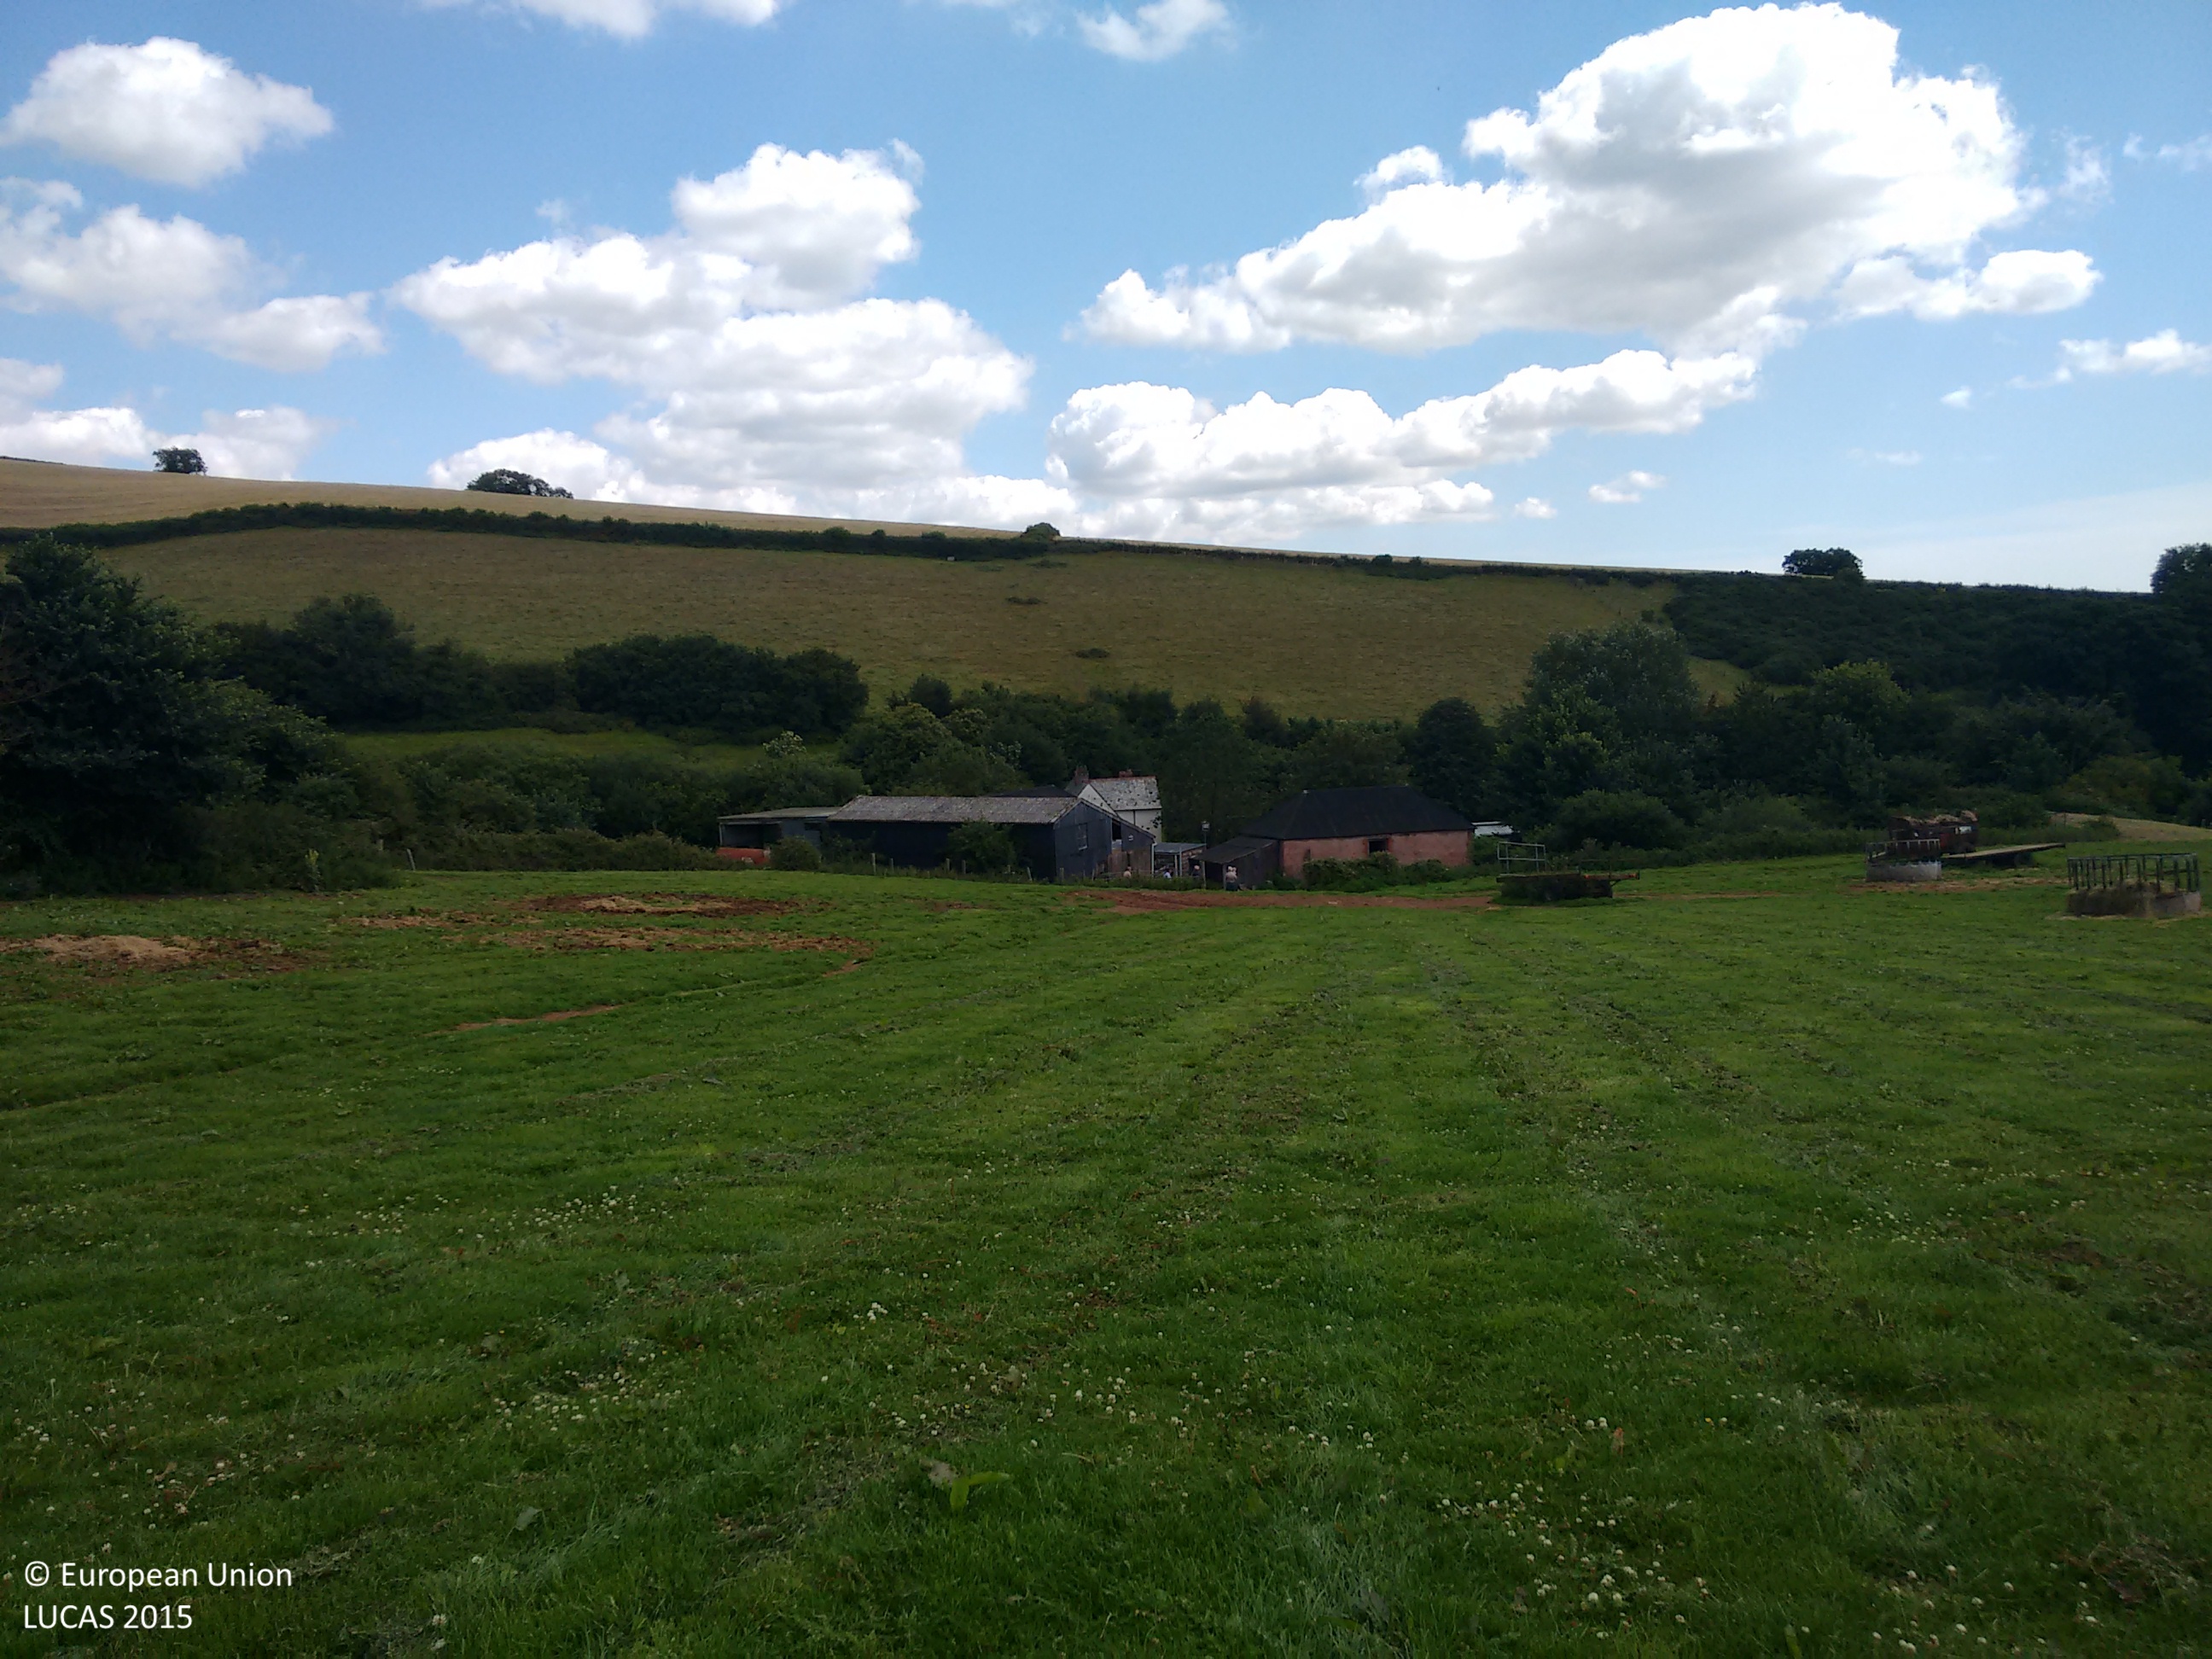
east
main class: Grassland
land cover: Grassland without tree/shrub cover
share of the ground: > 75 %
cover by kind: herbaceous plants 100 %
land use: Agriculture (excluding fallow land and kitchen gardens)
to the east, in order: Grassland without tree/shrub cover; Other bare soil; Artificial constructions in urban areas; Broadleaved woodland; Shruby margins; Grassland without tree/shrub cover
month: July
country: GB
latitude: 50.8243
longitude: -3.4414
